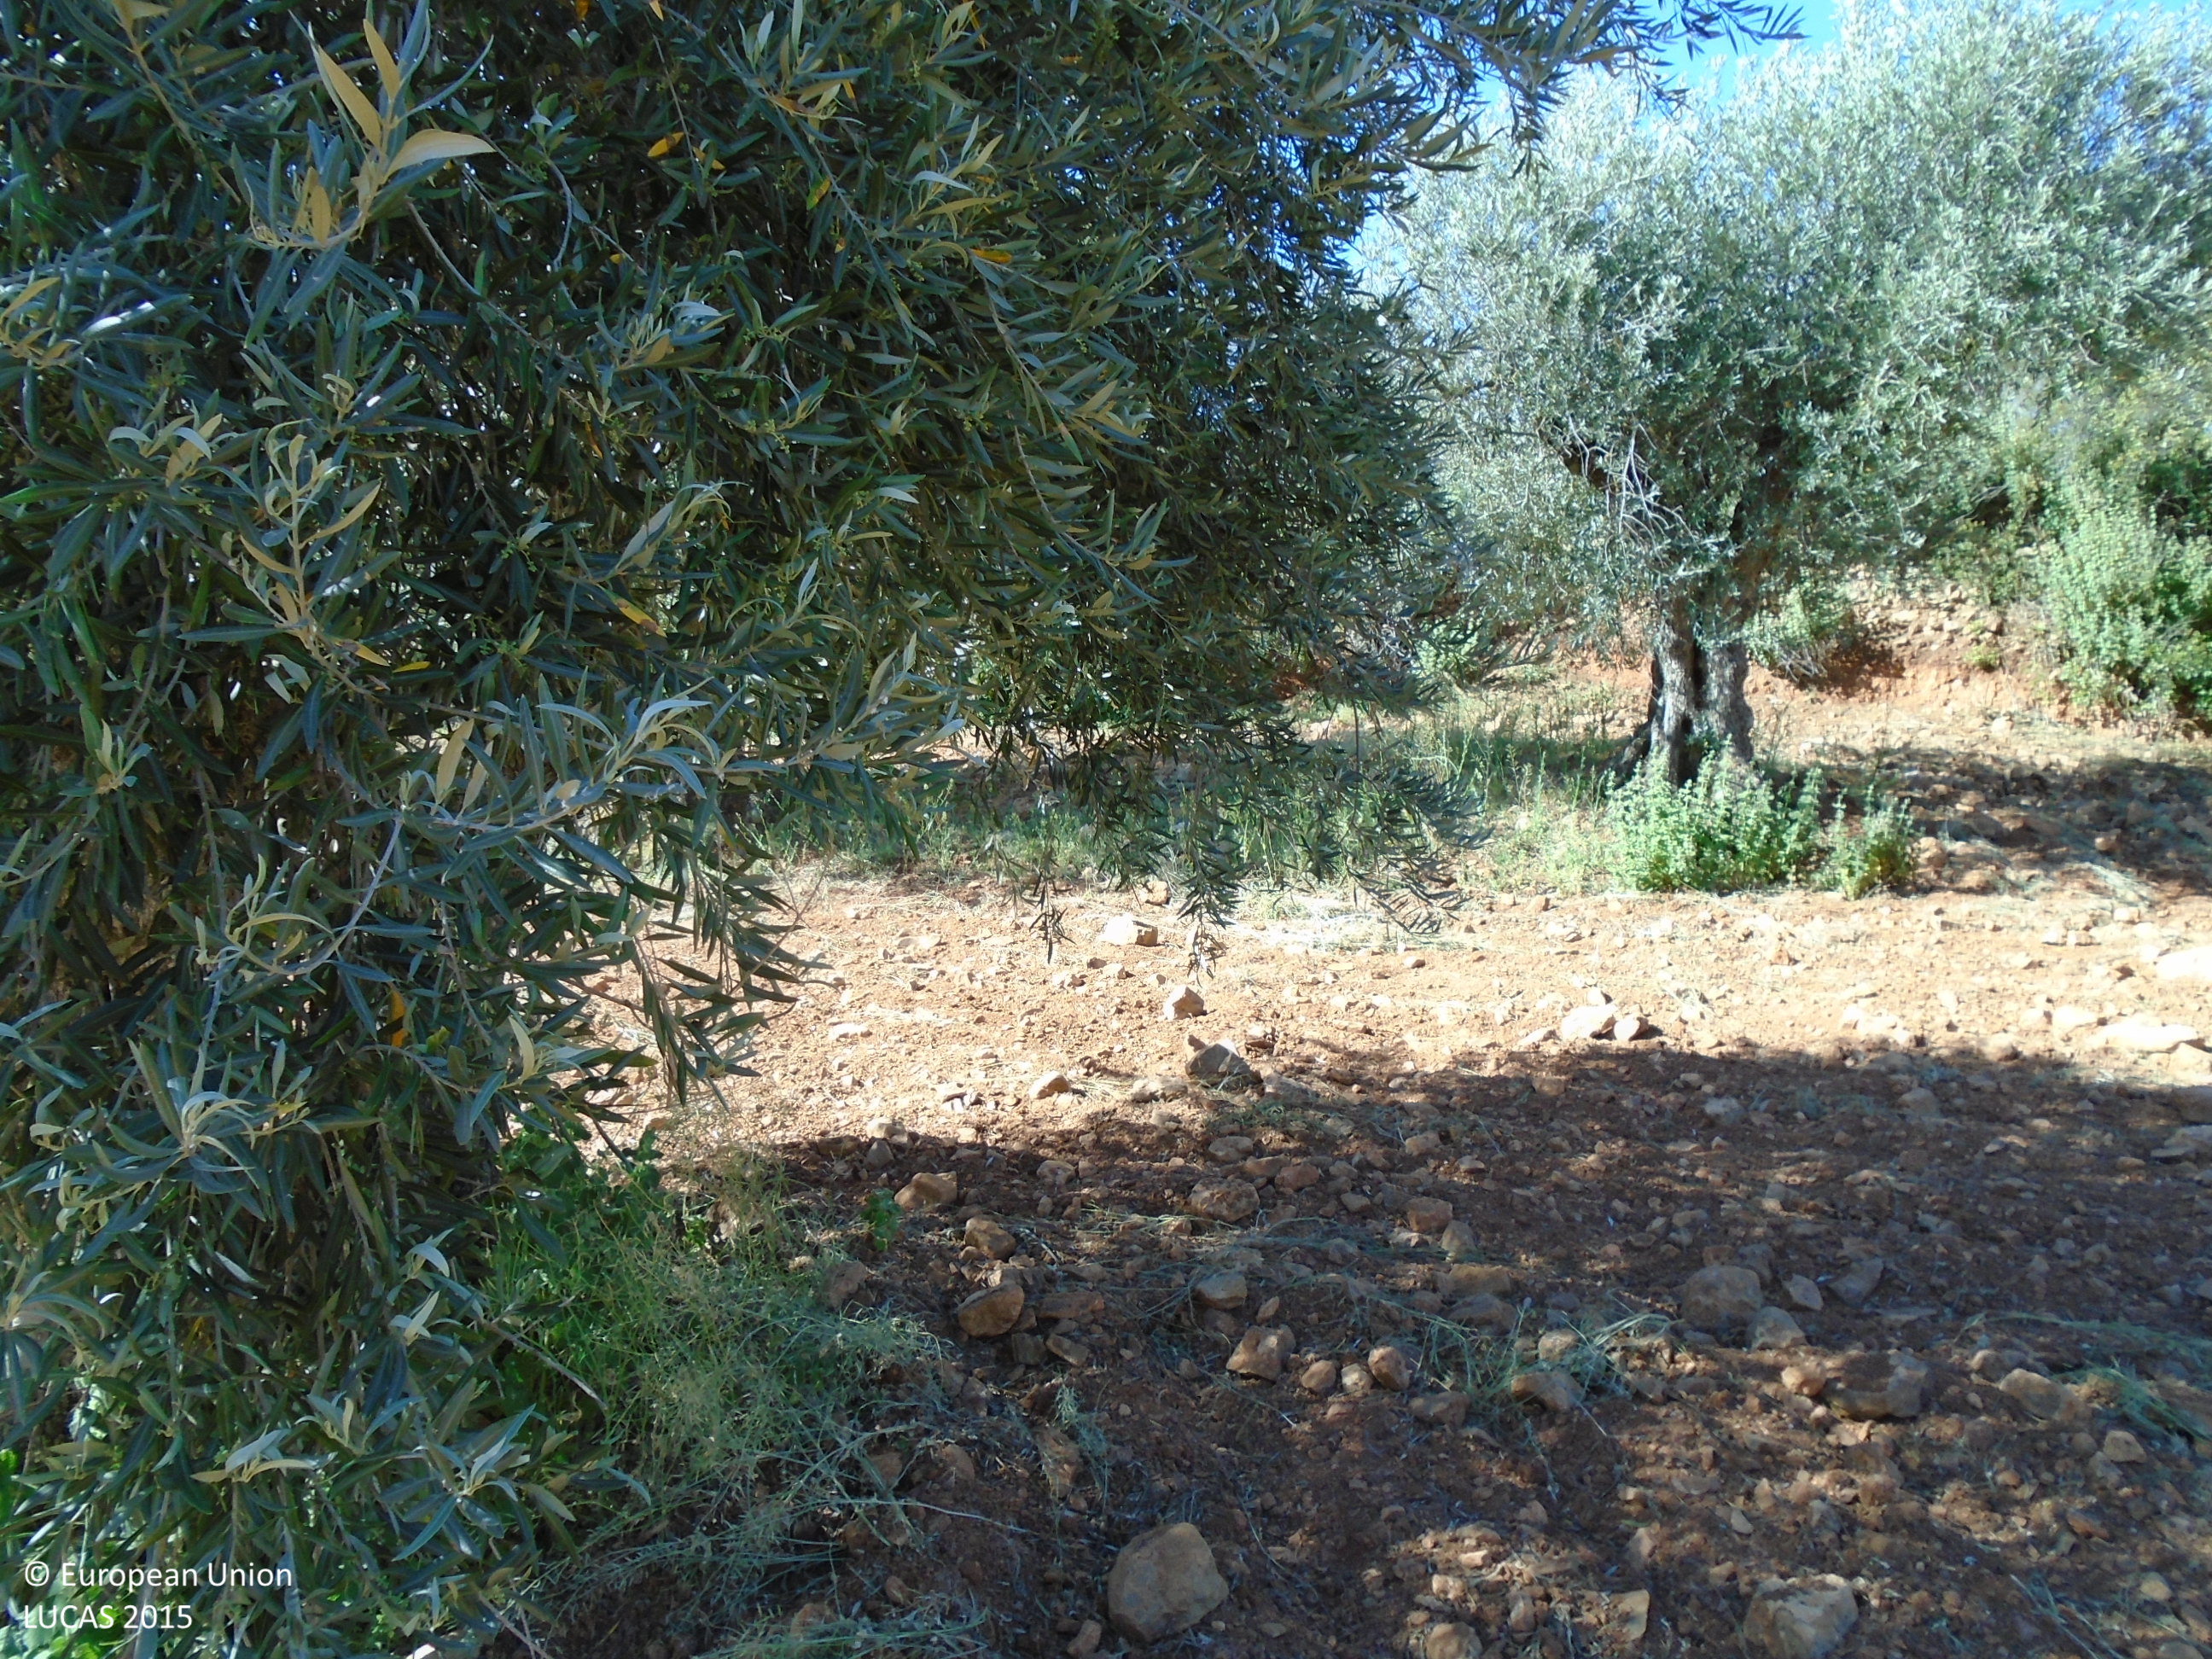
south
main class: Cropland
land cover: Olive groves
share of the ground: 10 - 25 %
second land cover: Other bare soil
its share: > 75 %
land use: Agriculture (excluding fallow land and kitchen gardens)
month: May
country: ES
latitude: 39.7209
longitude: -3.7125
